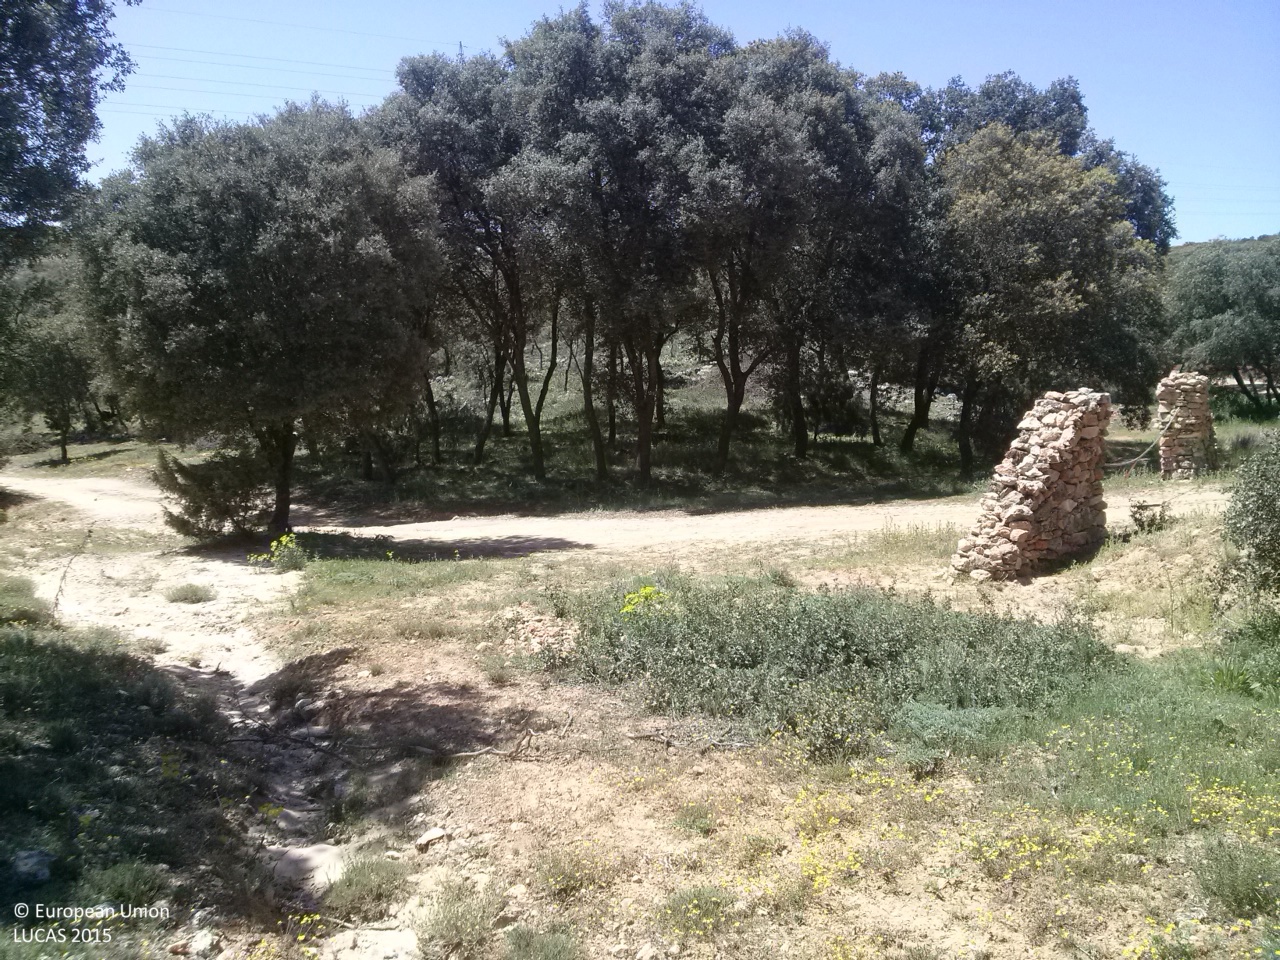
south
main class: Shrubland
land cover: Shrubland with sparse tree cover
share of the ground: 25 - 50 %
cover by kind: shrubs 45 %, herbaceous plants 25 %, unconsolidated bare surface 25 %, broadleaved forest trees 5 %
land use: Agriculture (excluding fallow land and kitchen gardens)
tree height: > 5 m
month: May
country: ES
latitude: 39.7637
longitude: -2.7298
